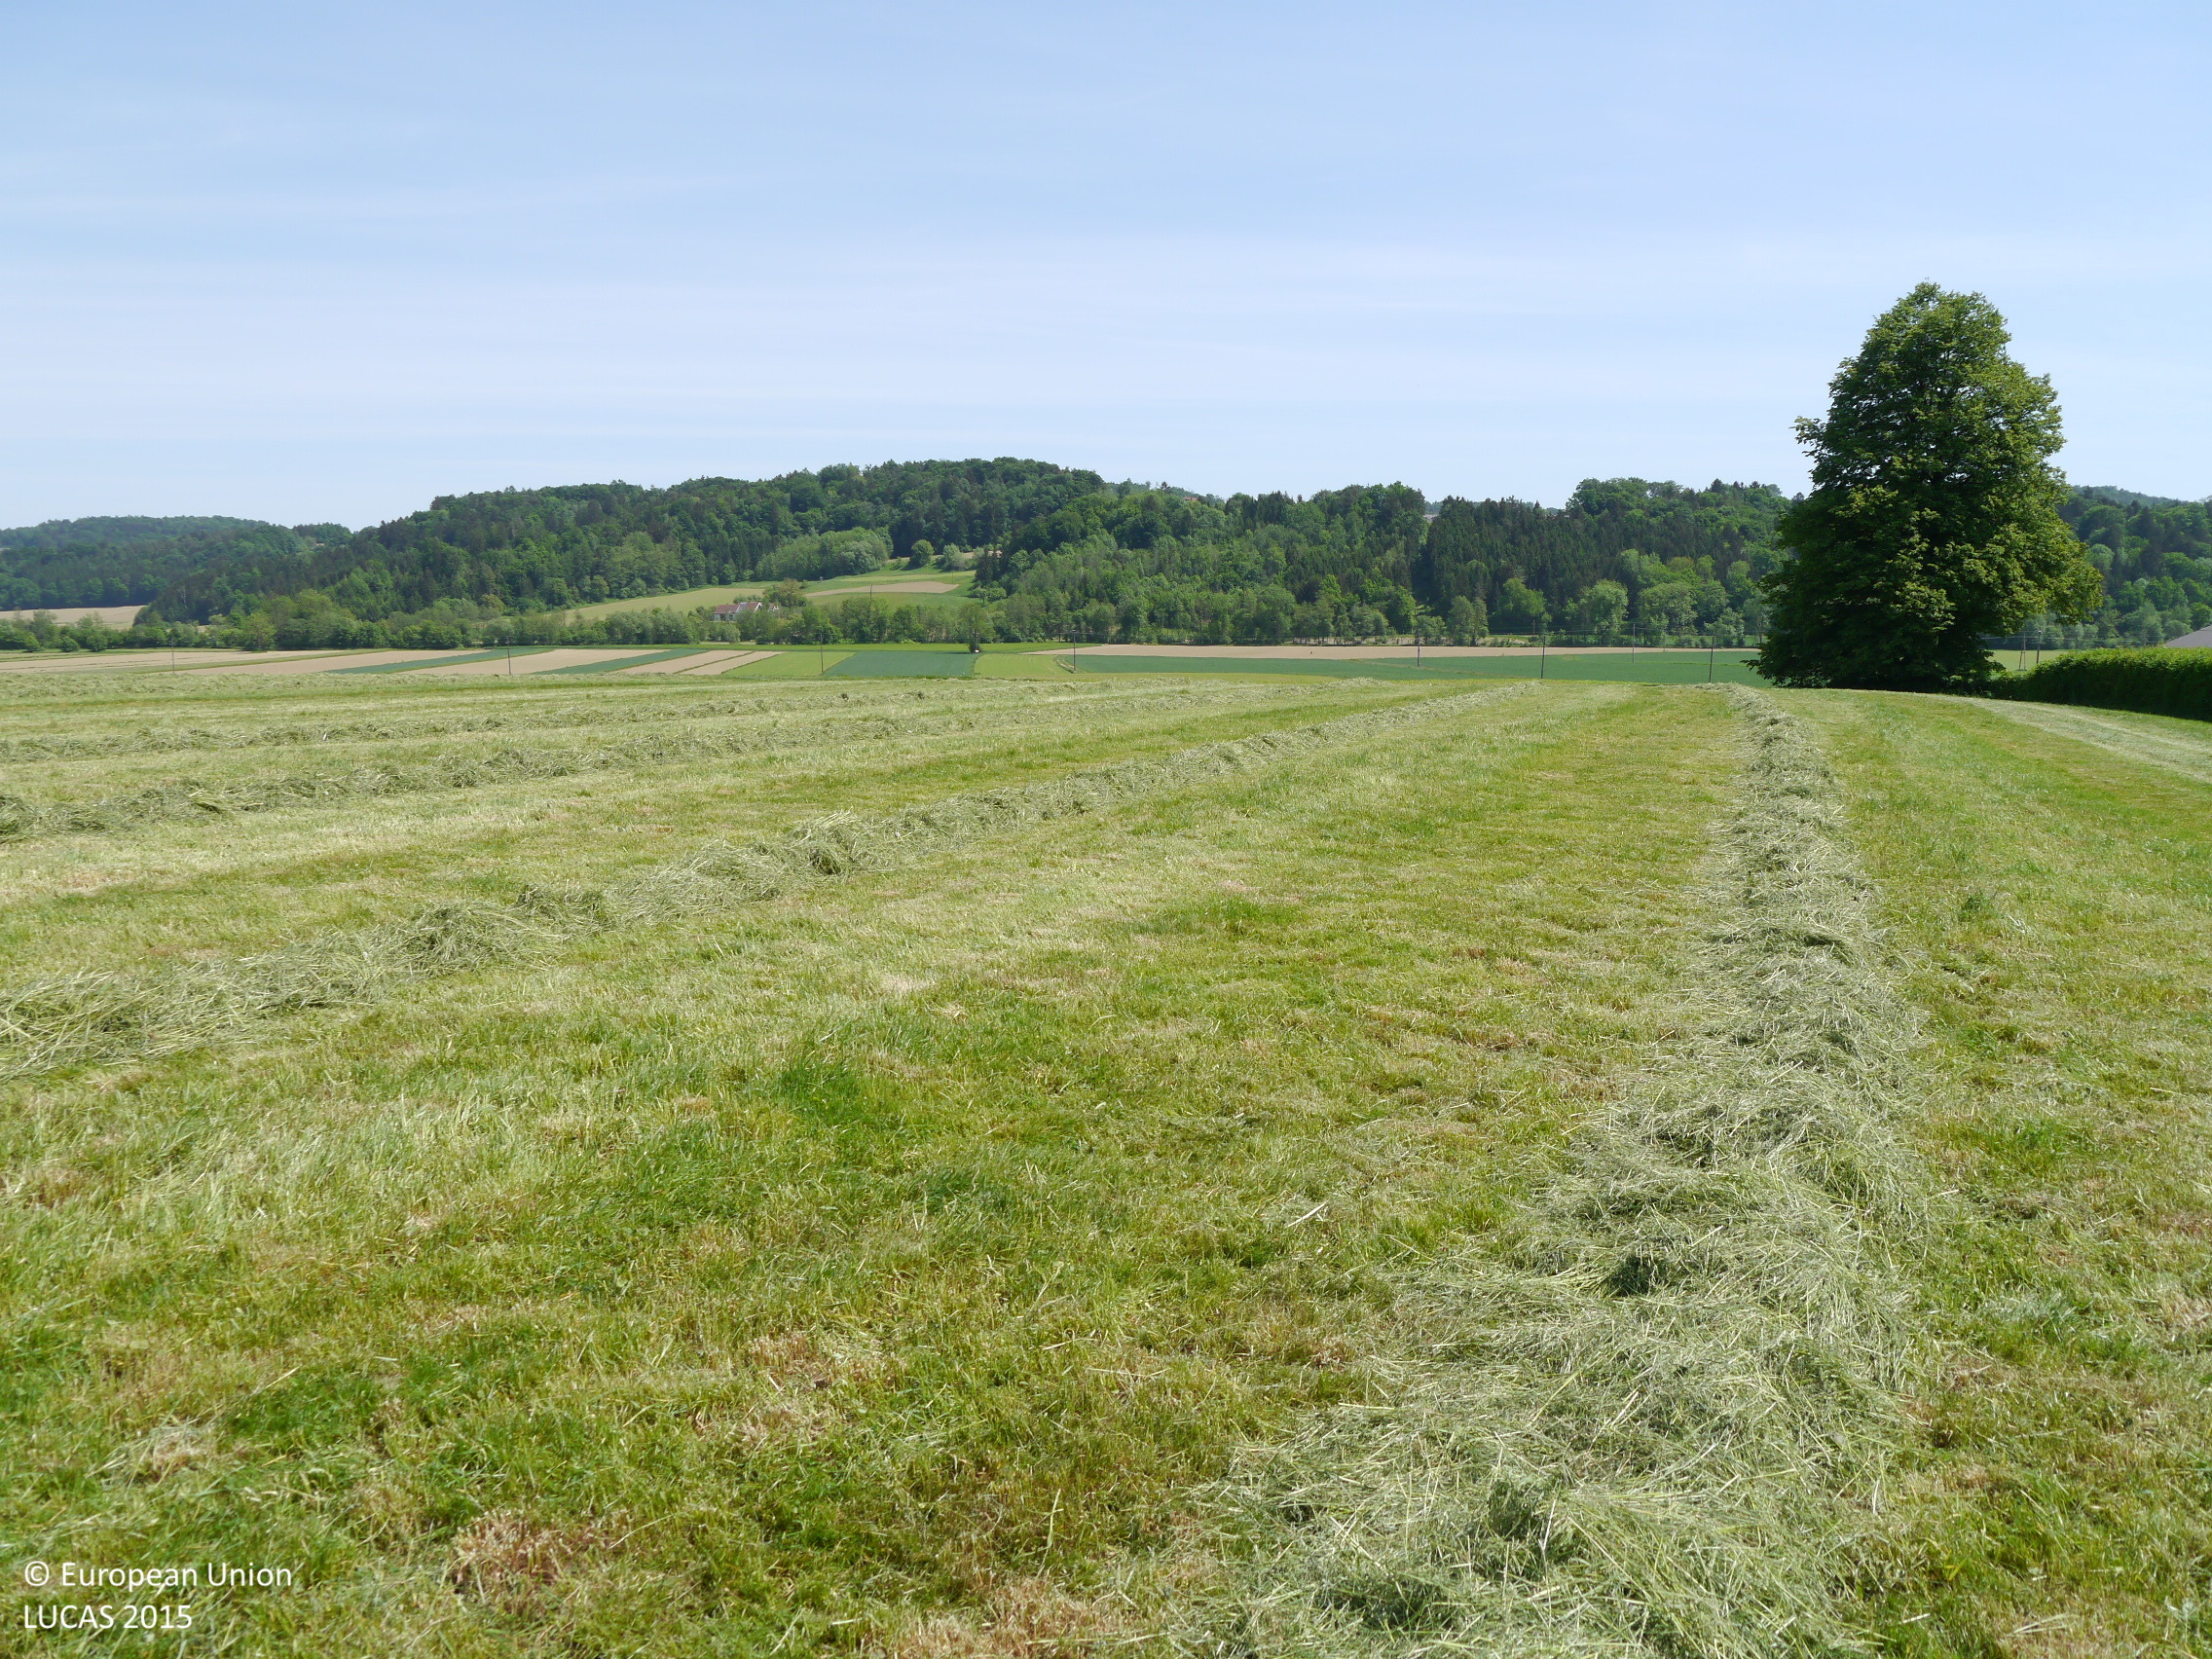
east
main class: Grassland
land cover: Grassland without tree/shrub cover
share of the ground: > 75 %
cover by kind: herbaceous plants 100 %
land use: Agriculture (excluding fallow land and kitchen gardens)
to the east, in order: Grassland without tree/shrub cover; Tracks; Grassland without tree/shrub cover; Tracks; Maize
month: May
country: AT
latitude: 46.9813
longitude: 15.5873
